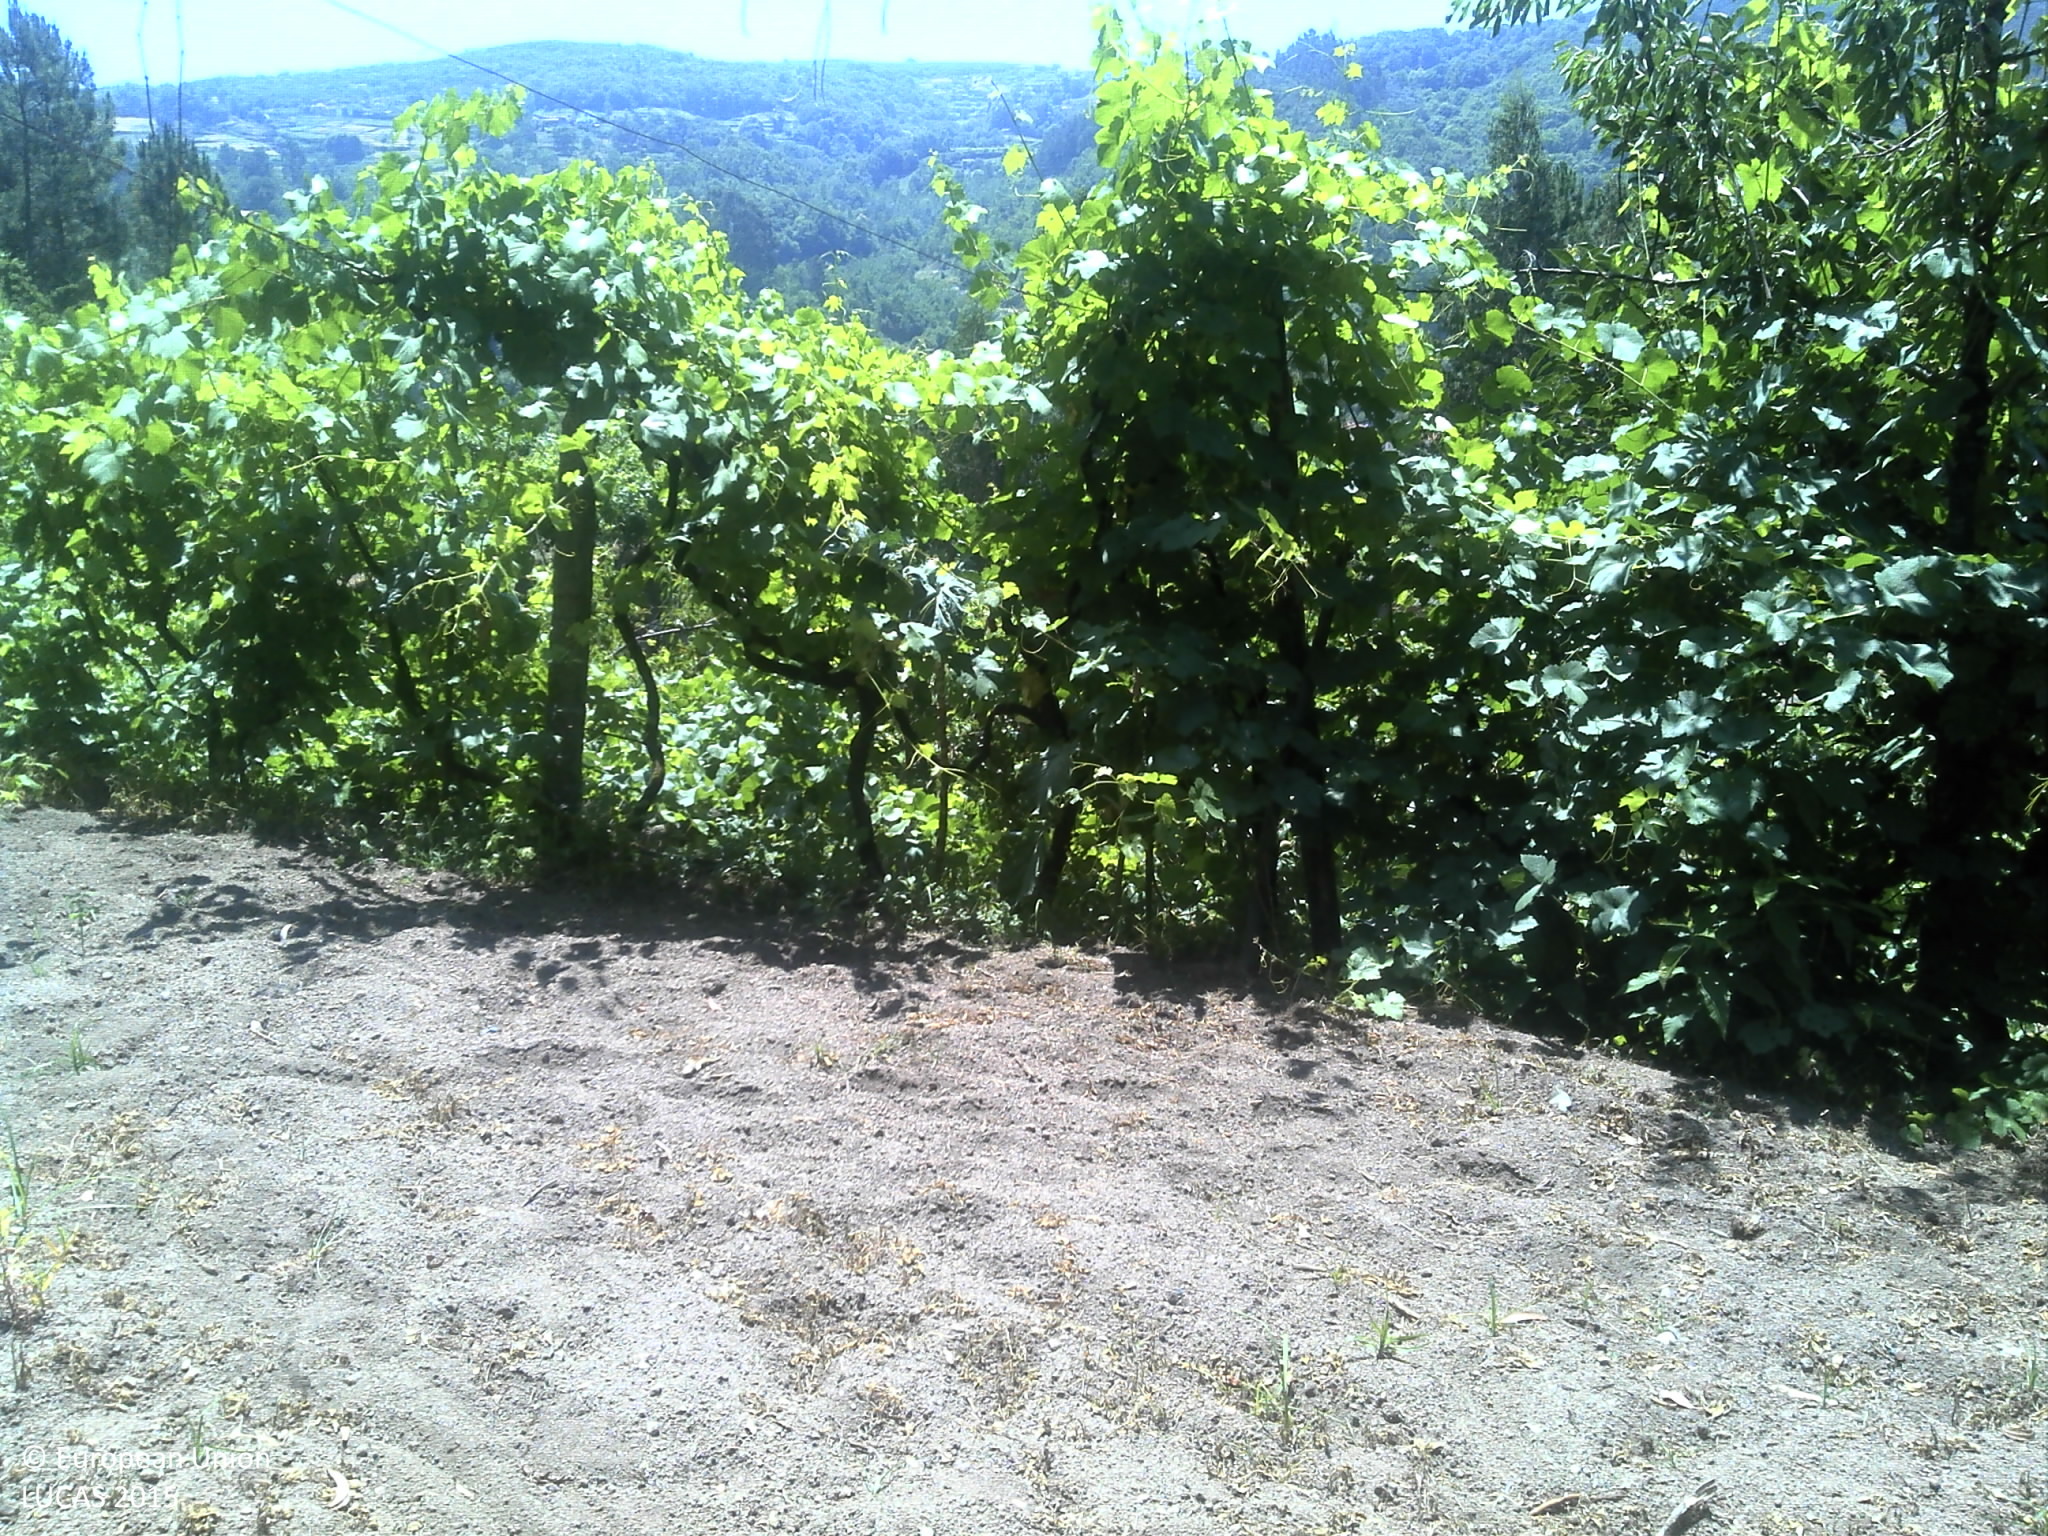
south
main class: Cropland
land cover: Vineyards
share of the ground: 50 - 75 %
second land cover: Other bare soil
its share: > 75 %
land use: Agriculture (excluding fallow land and kitchen gardens)
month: June
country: PT
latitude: 41.2295
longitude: -7.9954
